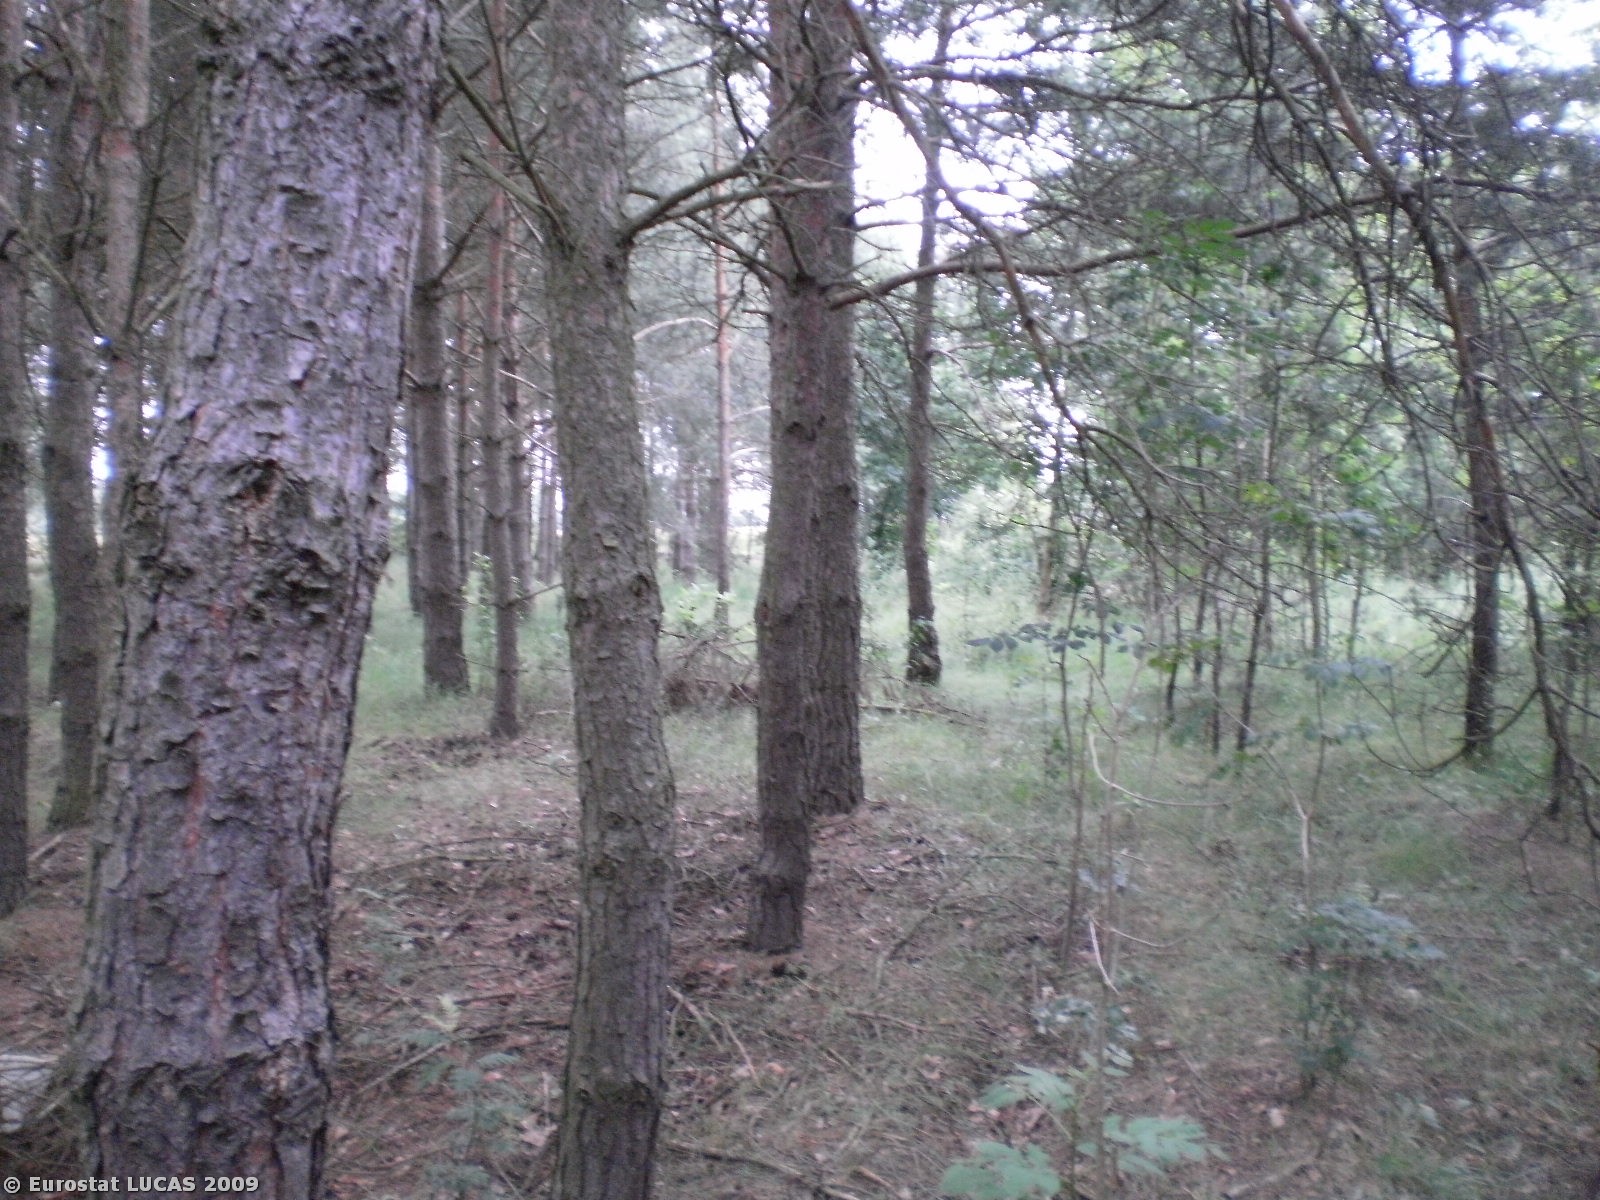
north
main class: Woodland
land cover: Coniferous woodland
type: hemiboreal forest and nemoral coniferous forest and mixed broadleaved-coniferous forest
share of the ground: > 75 %
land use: Forestry
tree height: > 5 m
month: July
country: PL
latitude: 52.7680
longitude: 20.8467
